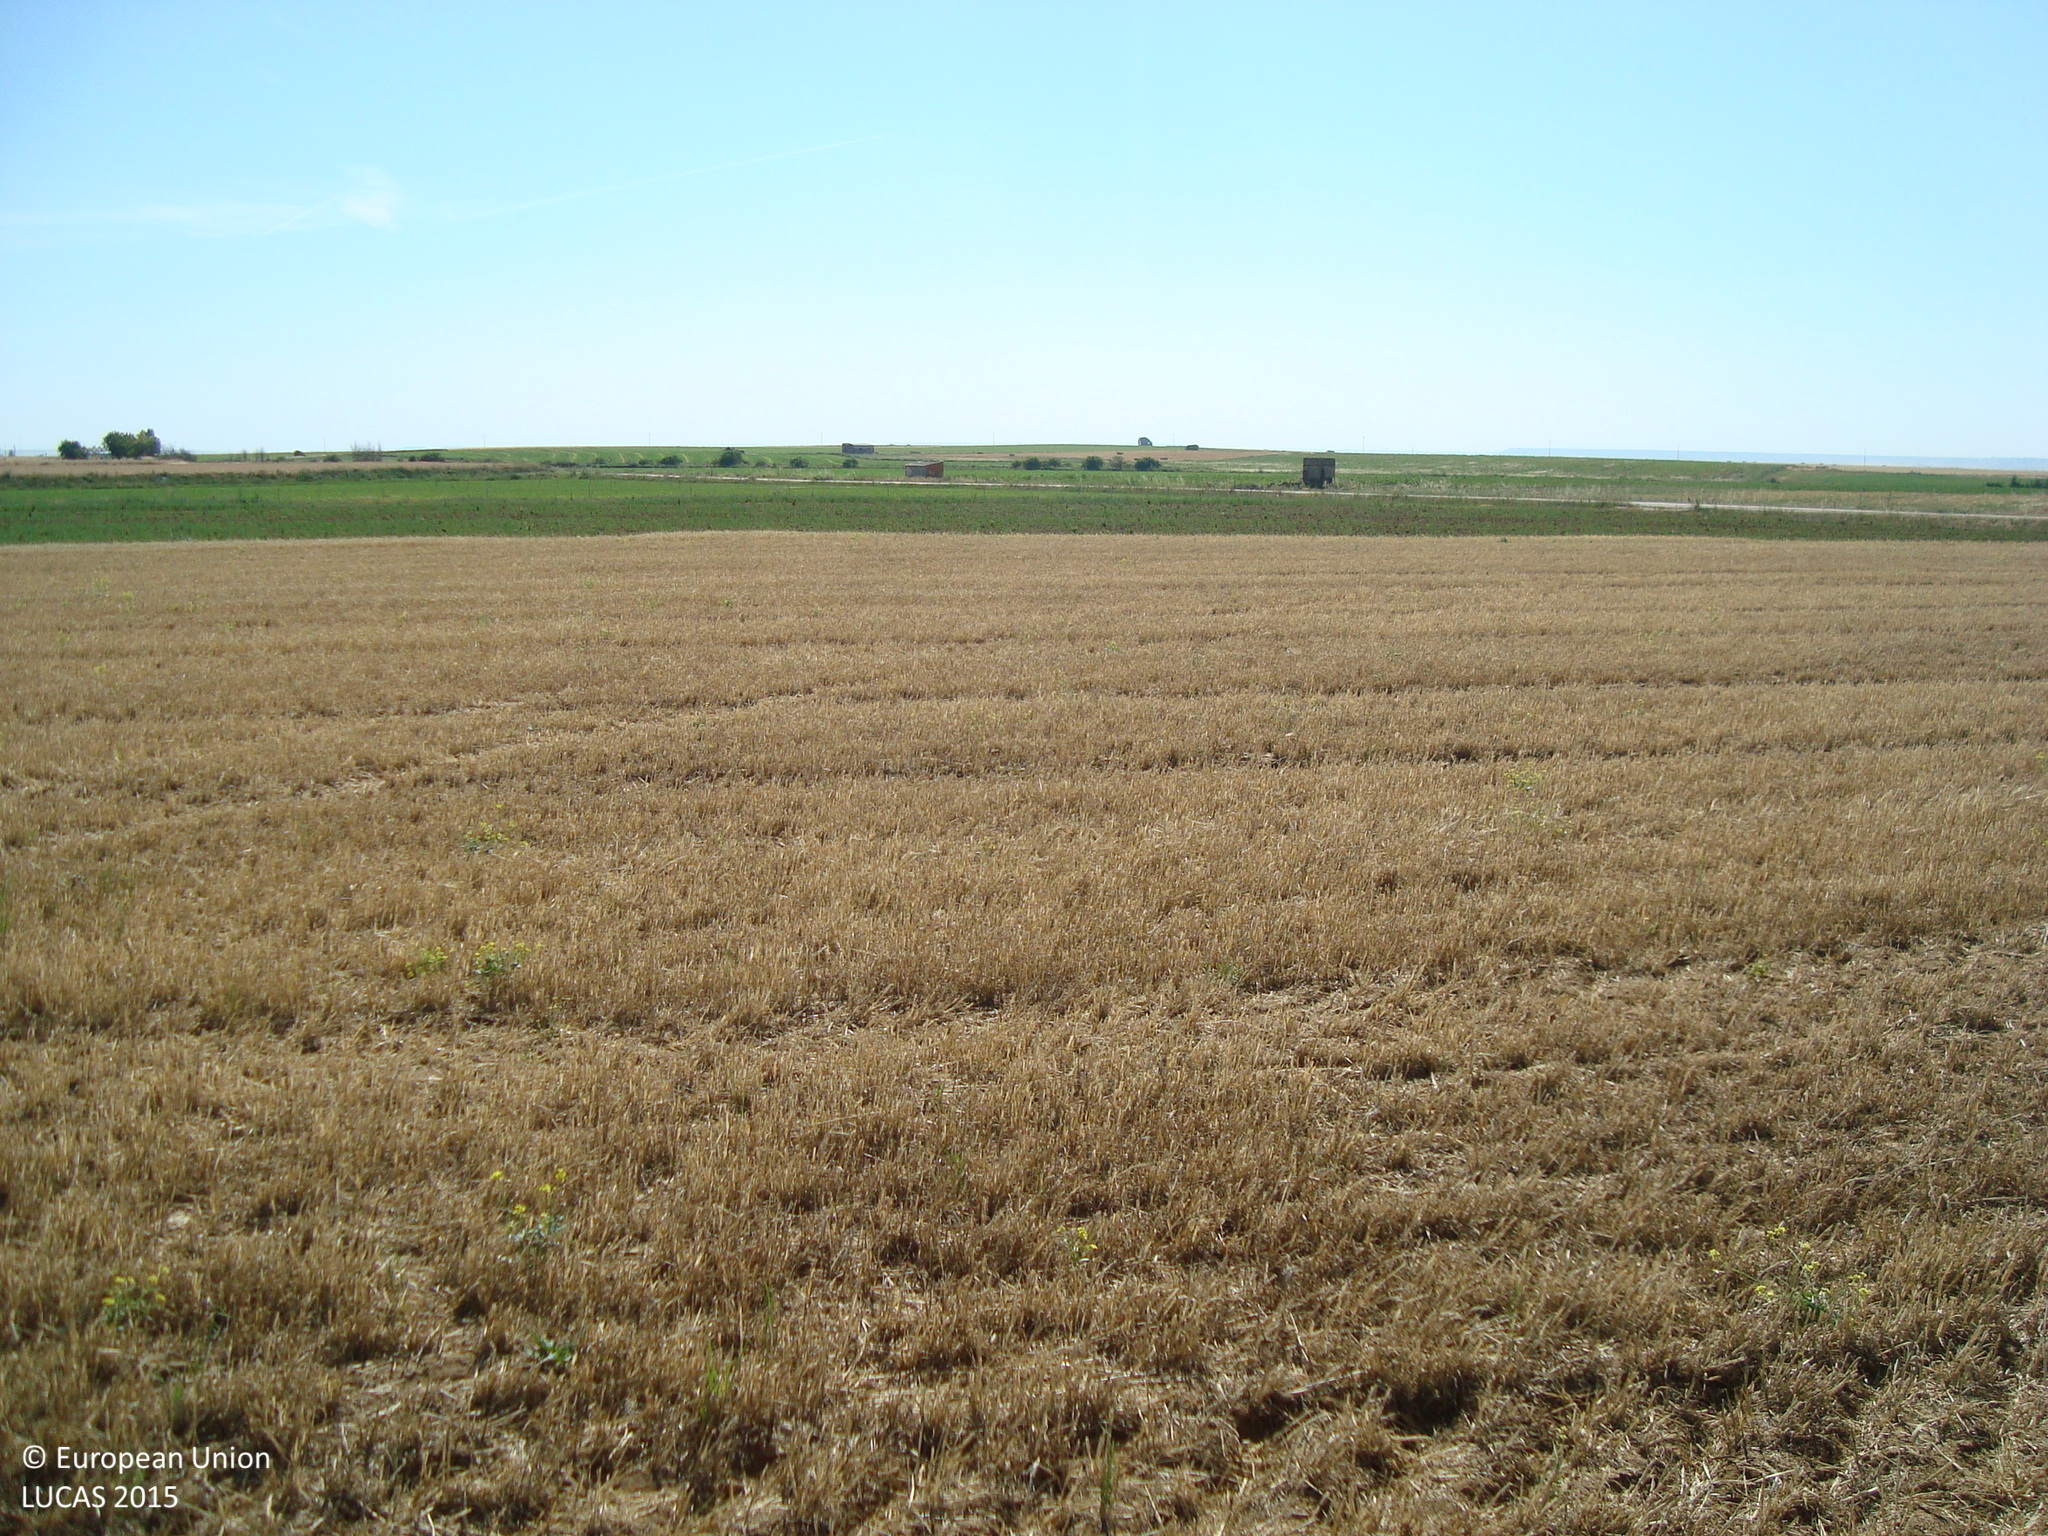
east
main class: Cropland
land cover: Barley
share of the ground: < 10 %
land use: Agriculture (excluding fallow land and kitchen gardens)
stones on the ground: < 10 %
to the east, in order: Barley; Grass margins; Lucerne; Grass margins; Paved roads, cycling and walking lanes; Barley; Grass margins; Artificial constructions in urban areas; Lucerne
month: July
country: ES
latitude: 42.0718
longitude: -4.8091
